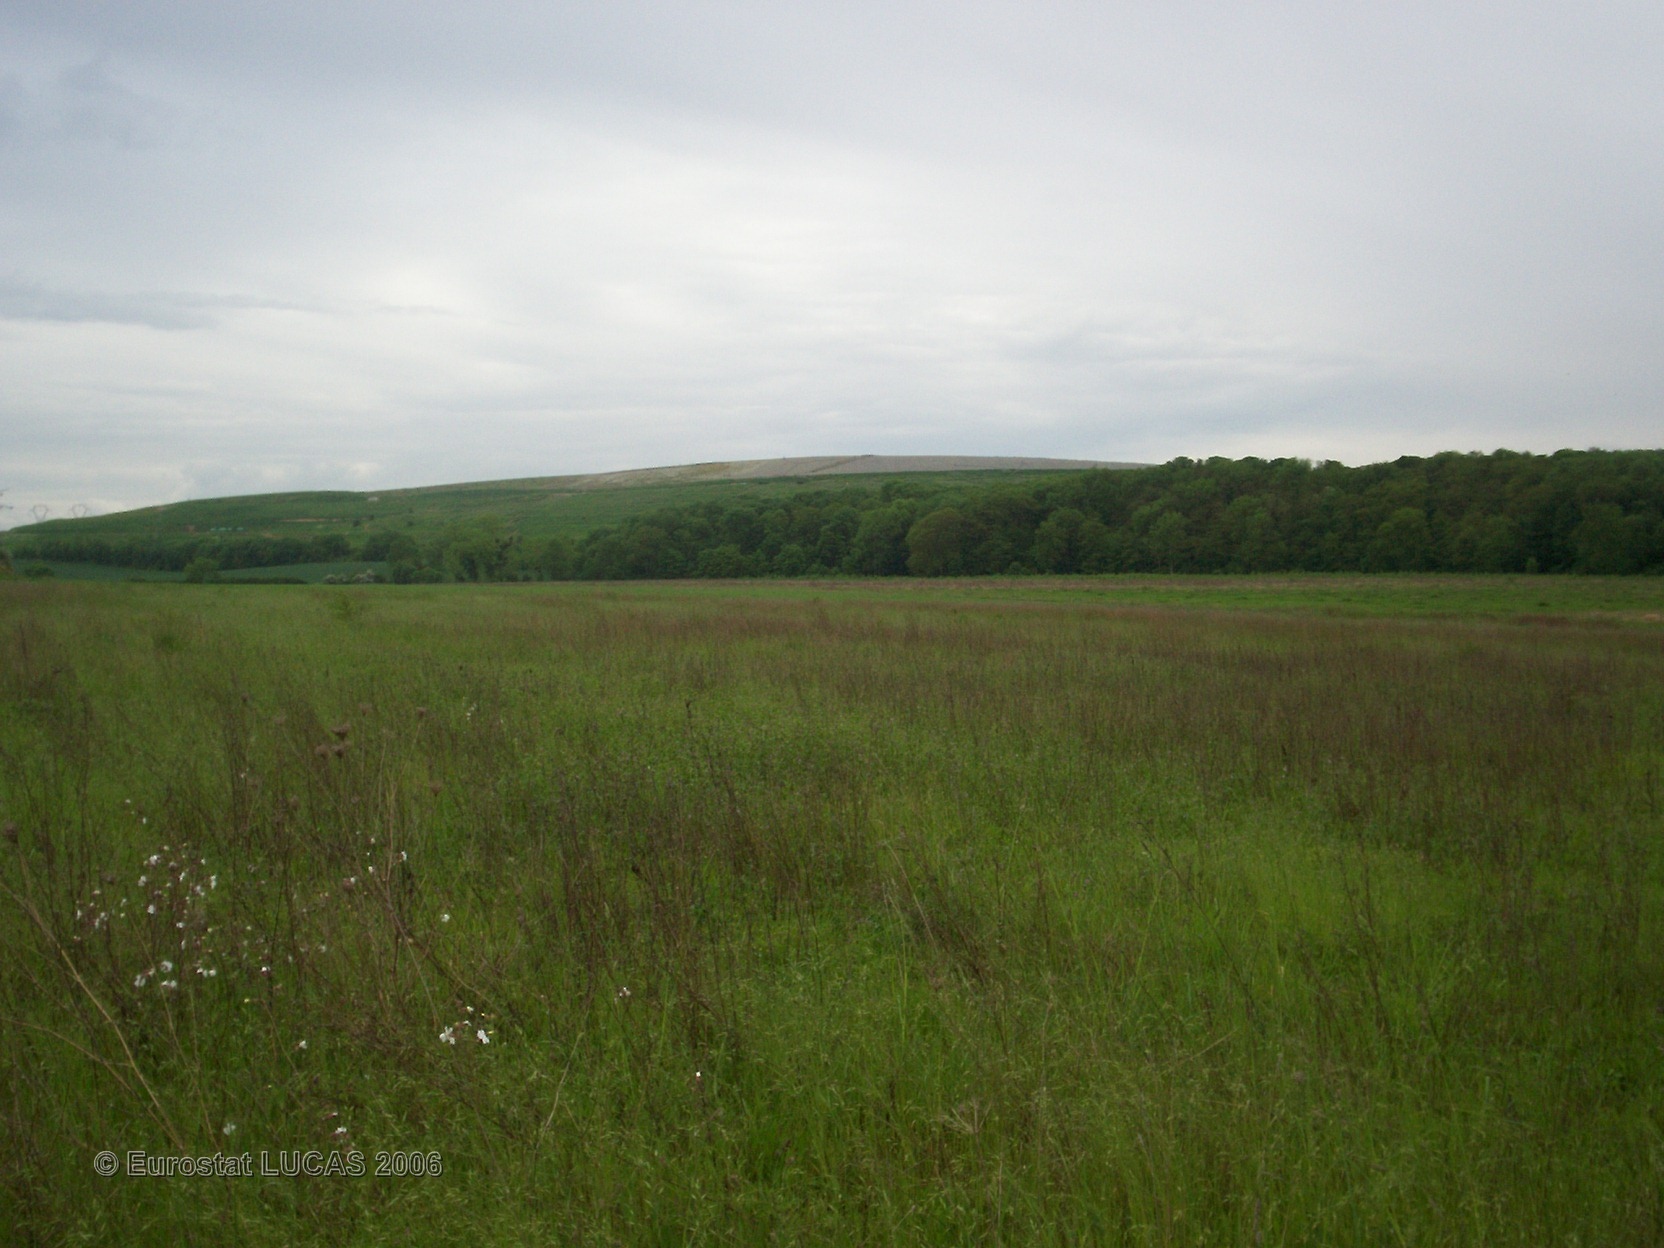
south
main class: Grassland
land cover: Grassland without tree/shrub cover
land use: Fallow land
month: May
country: FR
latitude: 48.6516
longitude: 2.7280
